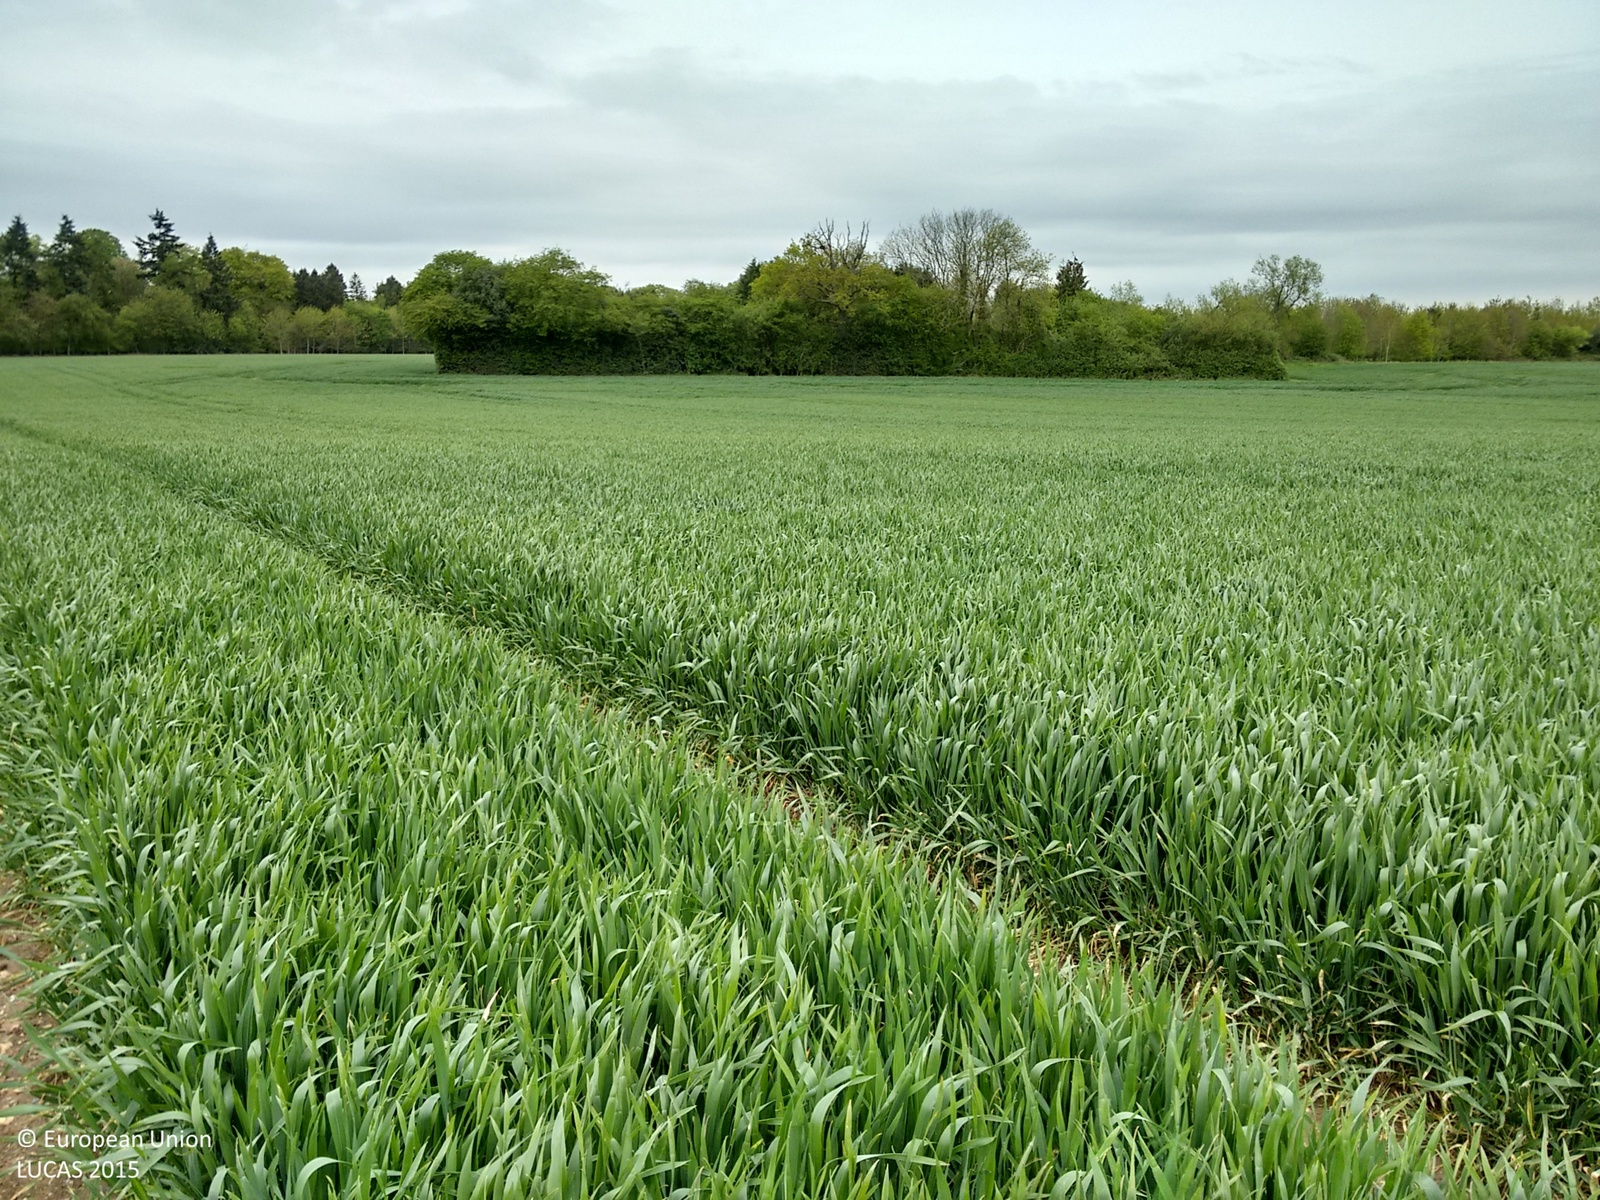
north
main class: Cropland
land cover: Common wheat
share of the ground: > 75 %
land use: Agriculture (excluding fallow land and kitchen gardens)
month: May
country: GB
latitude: 51.7563
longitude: -0.6006
